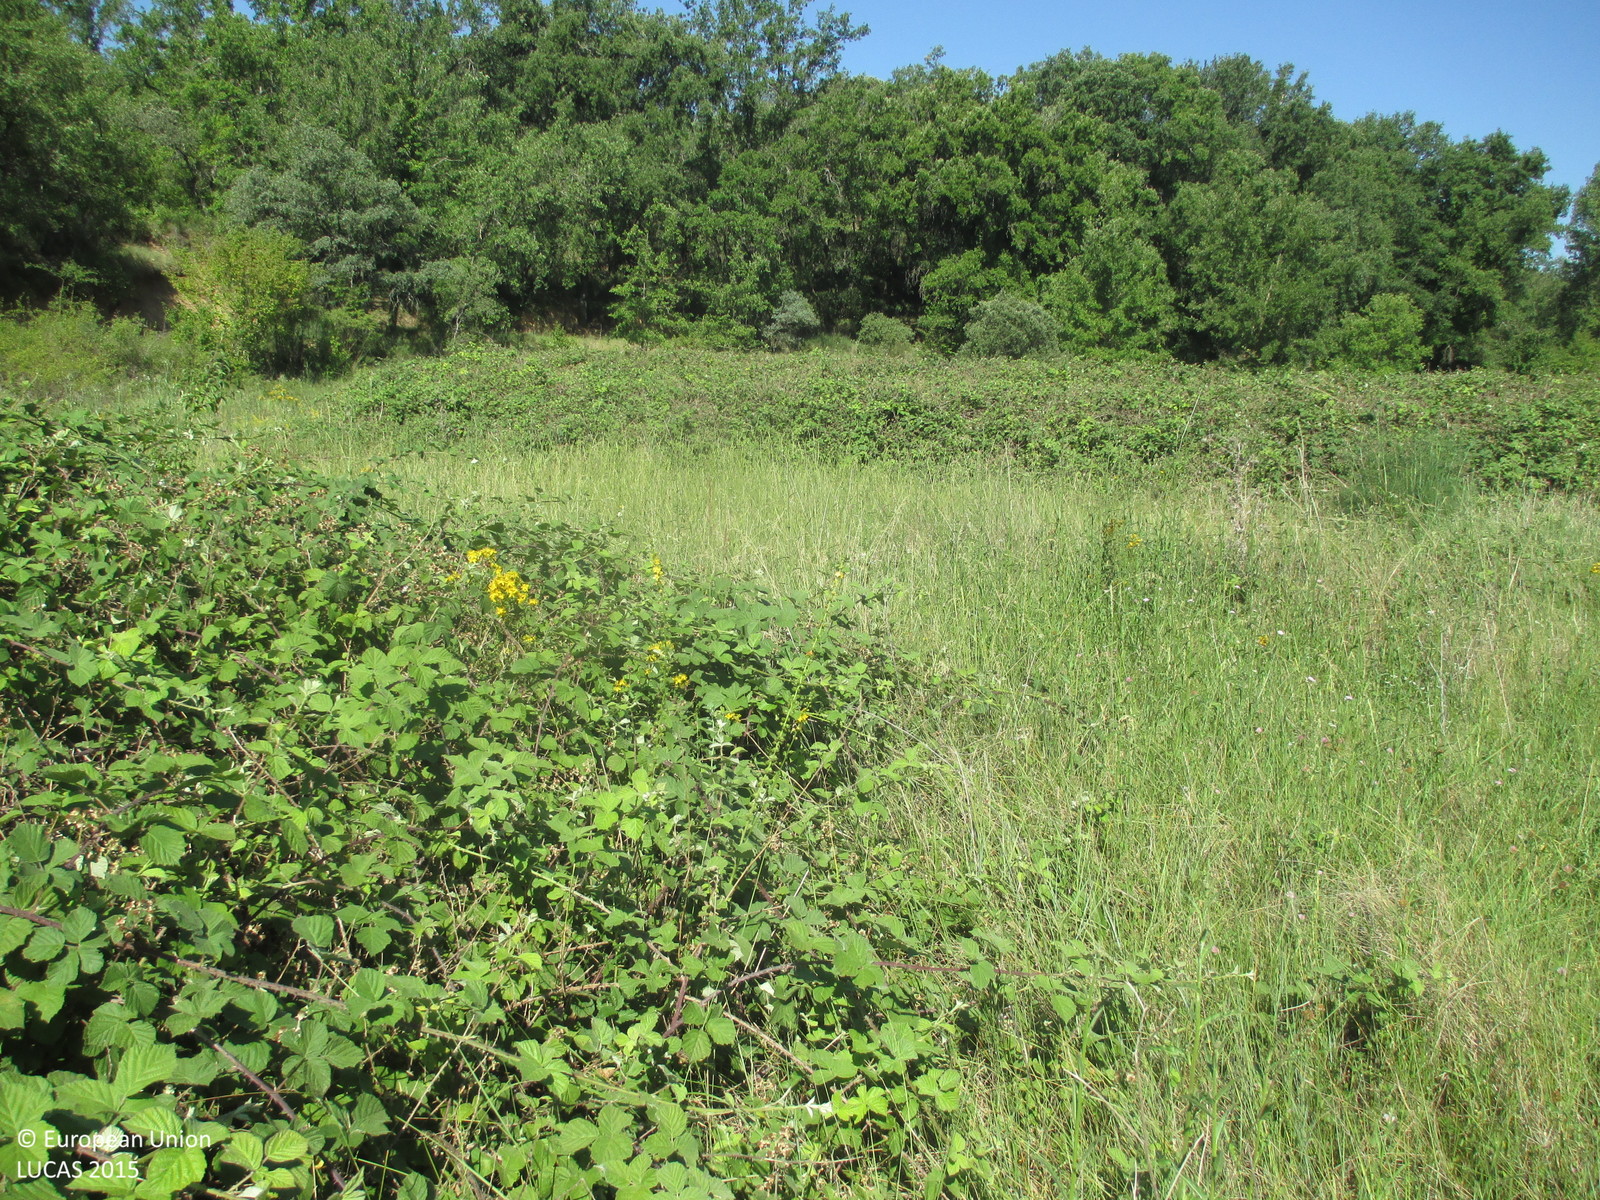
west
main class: Grassland
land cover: Grassland with sparse tree/shrub cover
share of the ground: > 75 %
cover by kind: herbaceous plants 90 %, broadleaved forest trees 5 %, shrubs 5 %
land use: Semi-natural and natural areas not in use
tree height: < 5 m
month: June
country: ES
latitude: 42.1575
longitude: -0.0047
